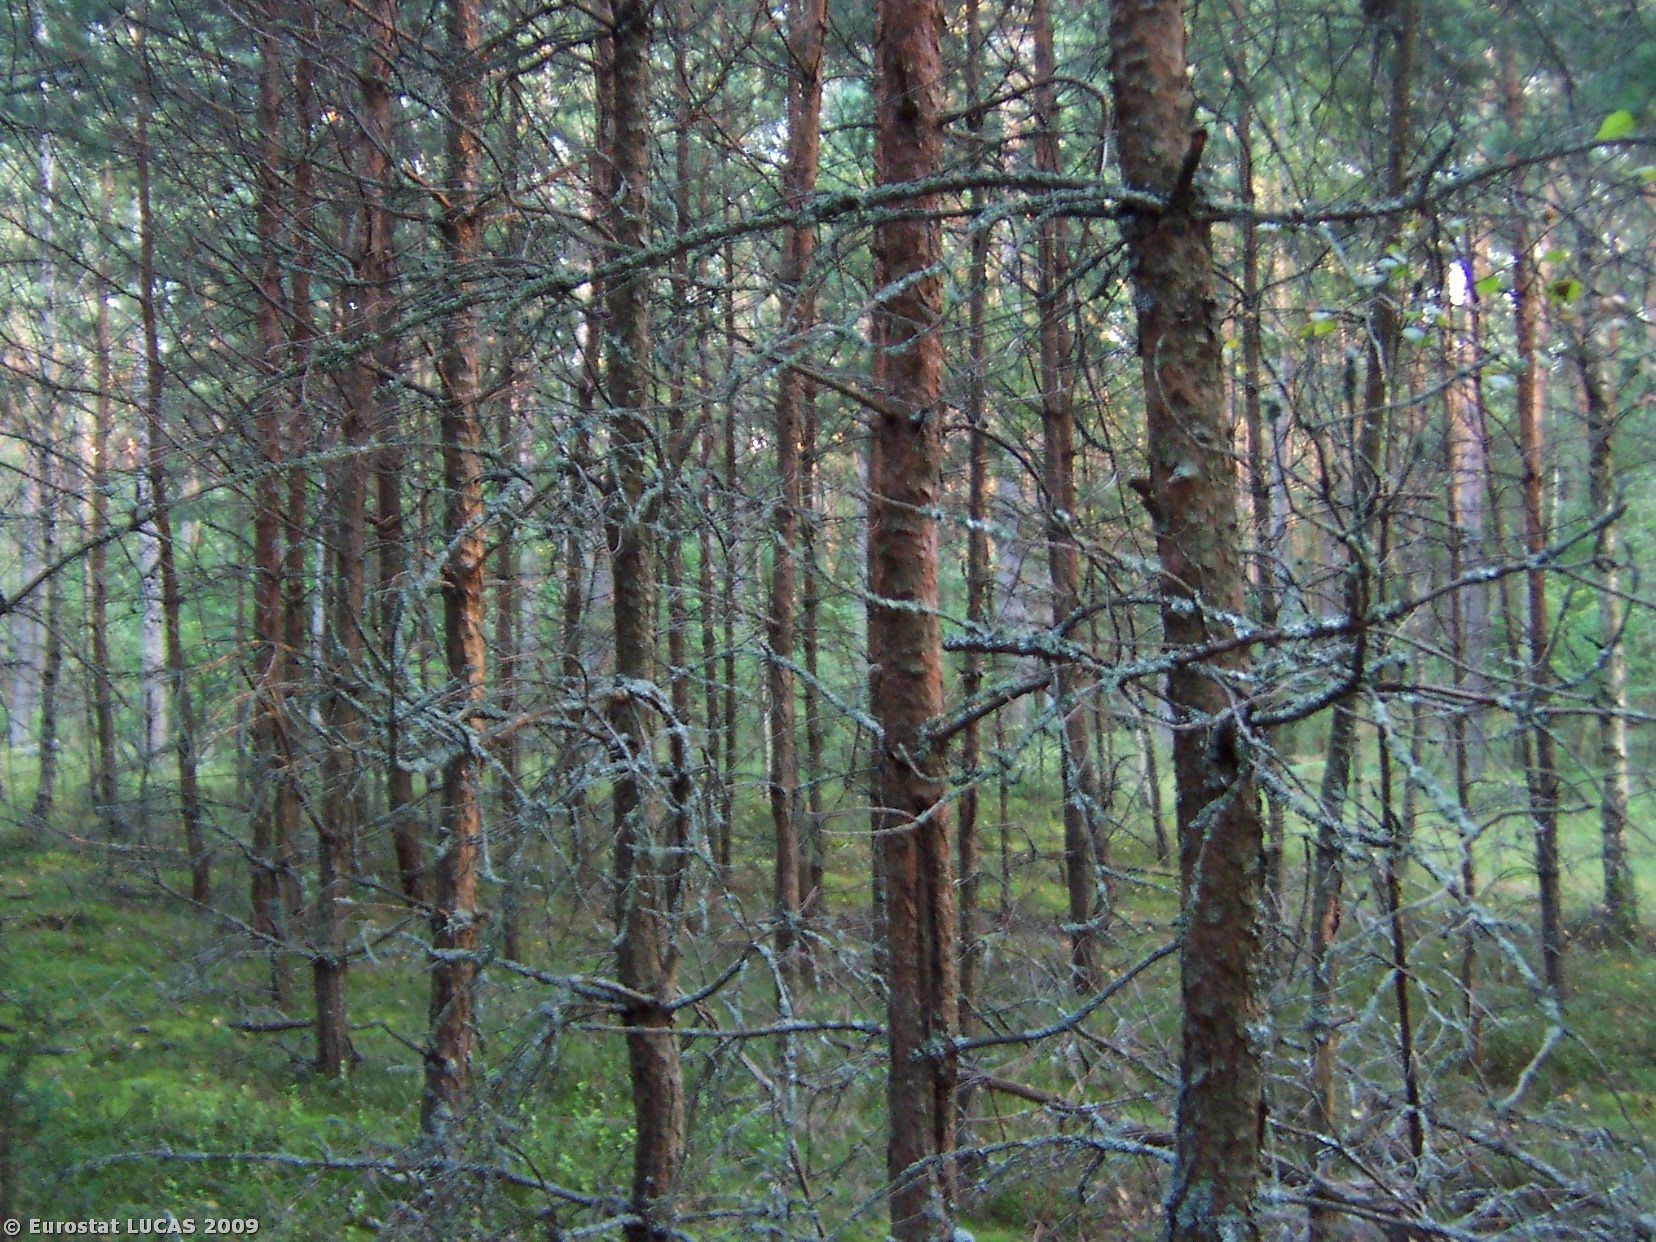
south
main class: Woodland
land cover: Mixed woodland
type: hemiboreal forest and nemoral coniferous forest and mixed broadleaved-coniferous forest
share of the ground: > 75 %
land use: Forestry
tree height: > 5 m
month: August
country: PL
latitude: 52.6994
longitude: 21.7597
